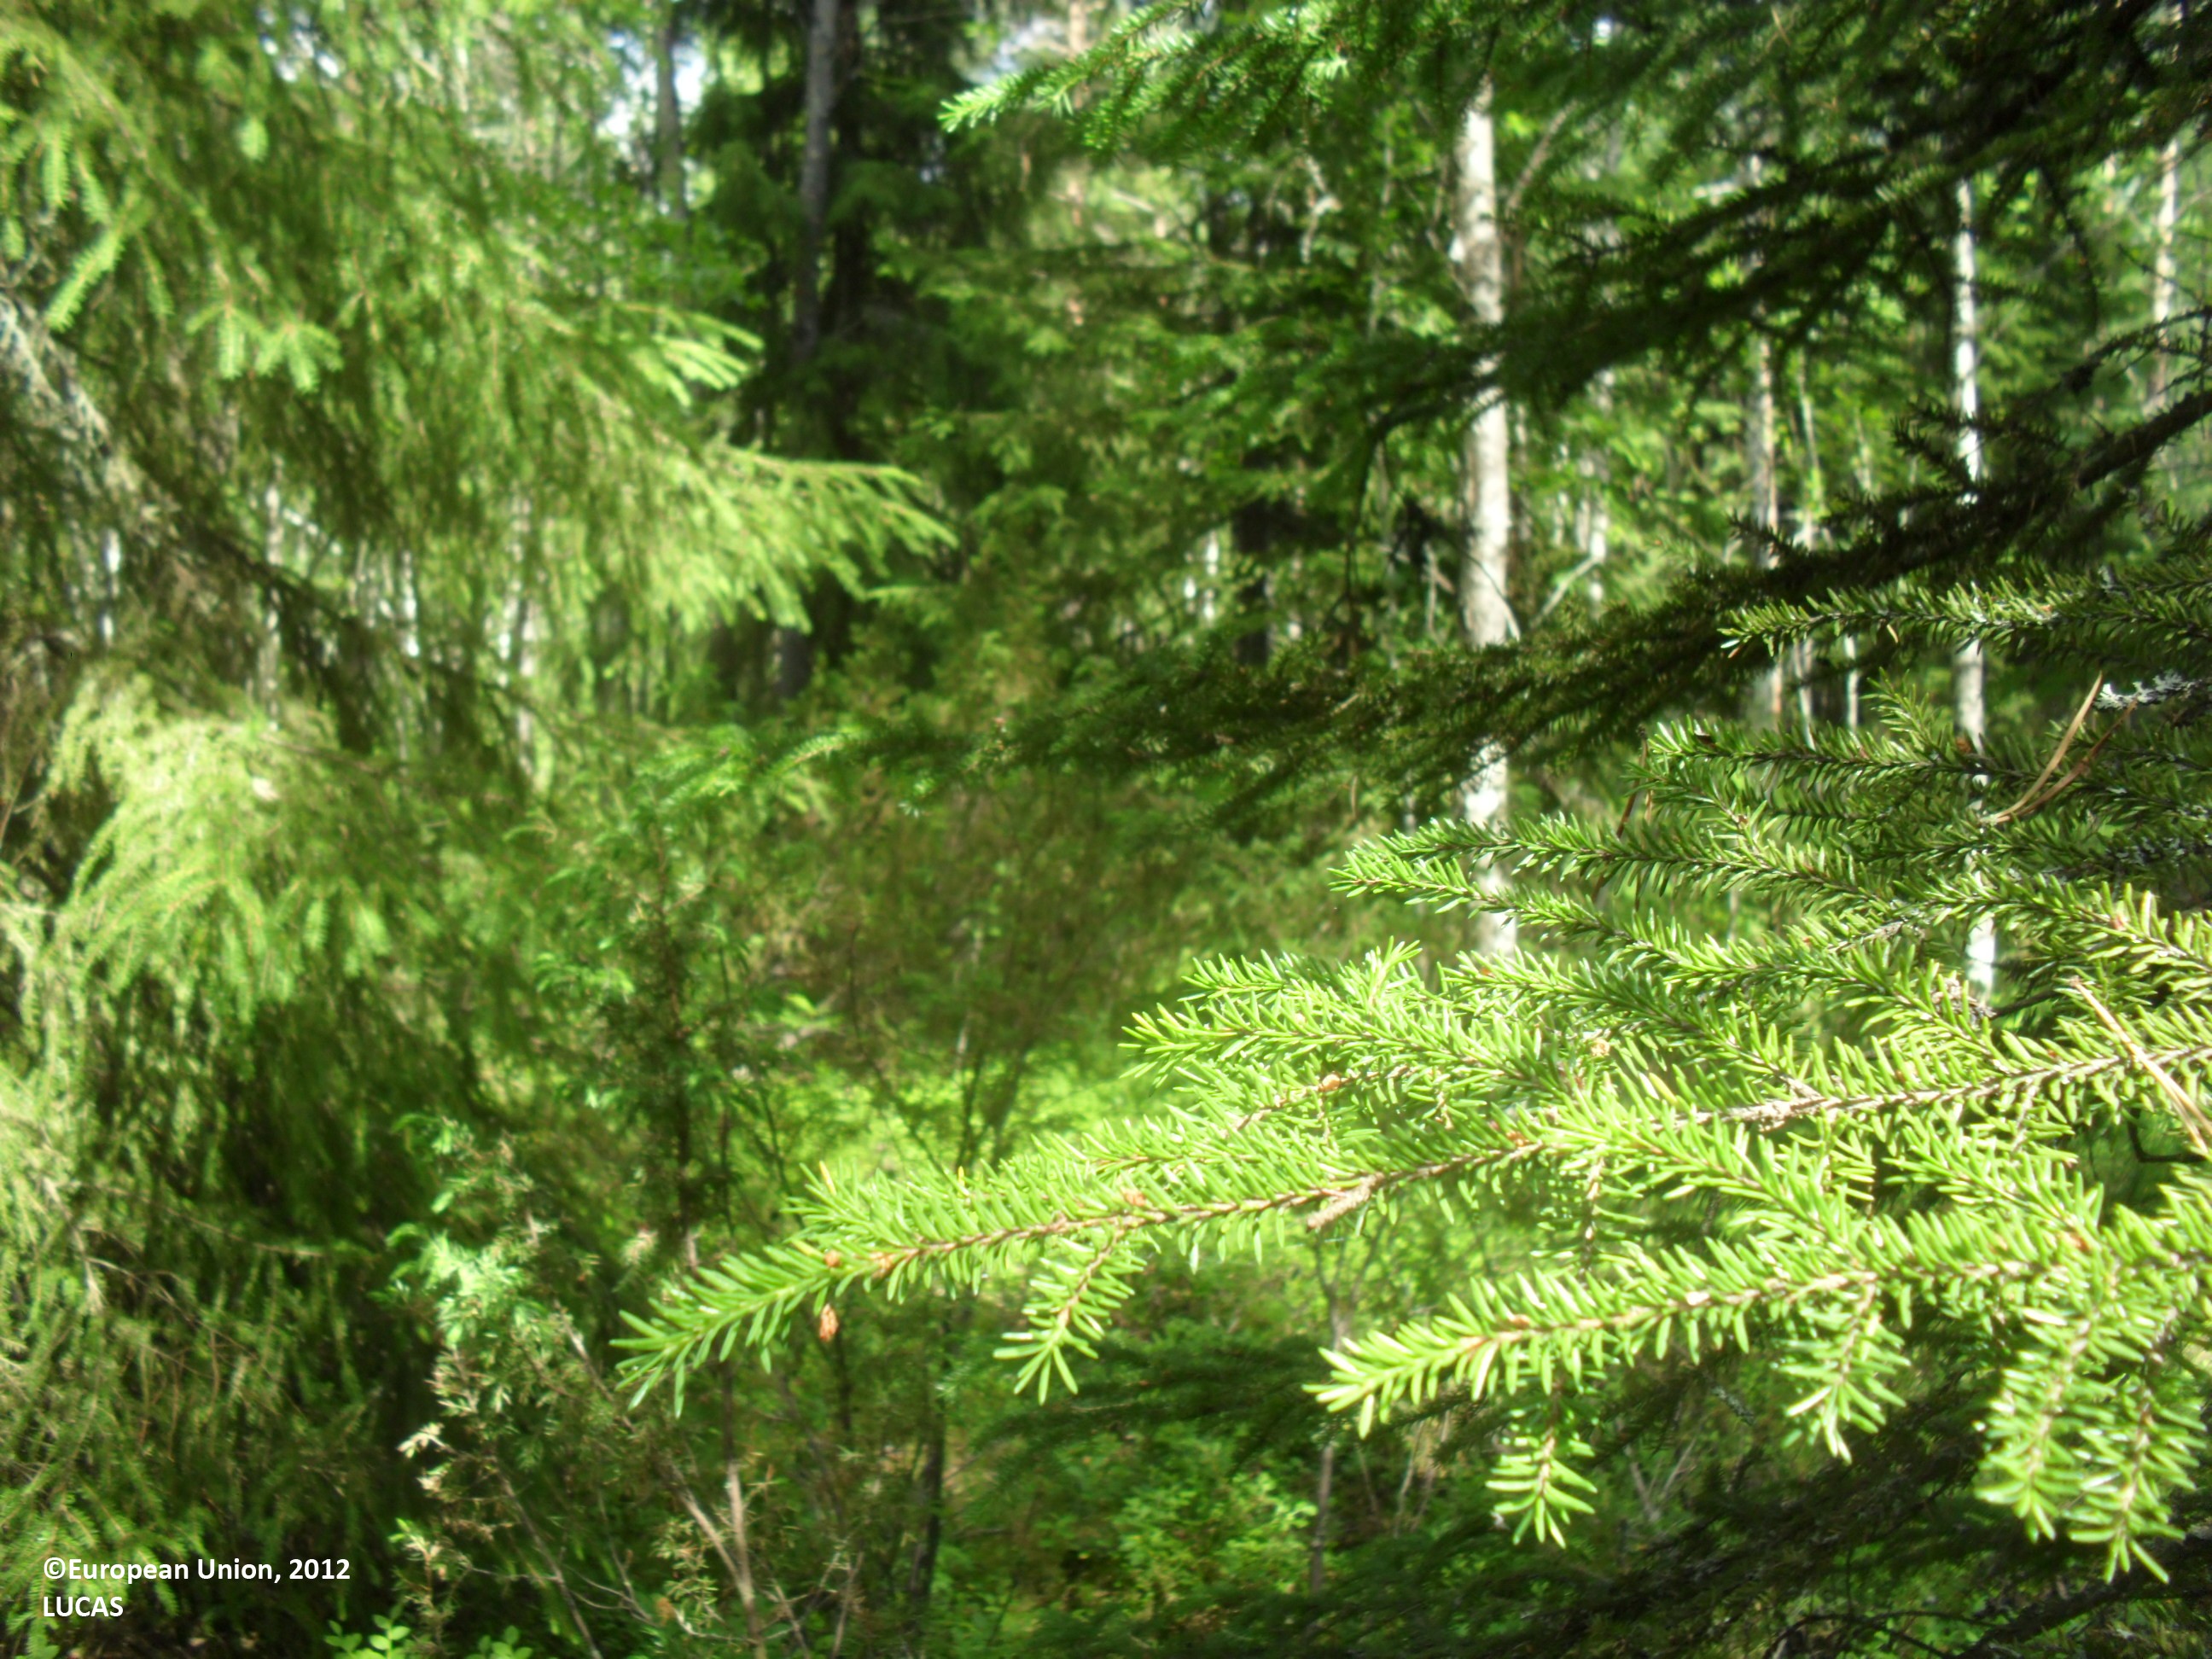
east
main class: Woodland
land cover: Other mixed woodland
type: boreal forest
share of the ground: 50 - 75 %
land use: Forestry
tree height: > 5 m
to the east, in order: Other mixed woodland; Pine dominated mixed woodland; Other mixed woodland; Pine dominated mixed woodland; Other mixed woodland; Broadleaved woodland
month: July
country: FI
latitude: 63.5689
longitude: 24.0248
